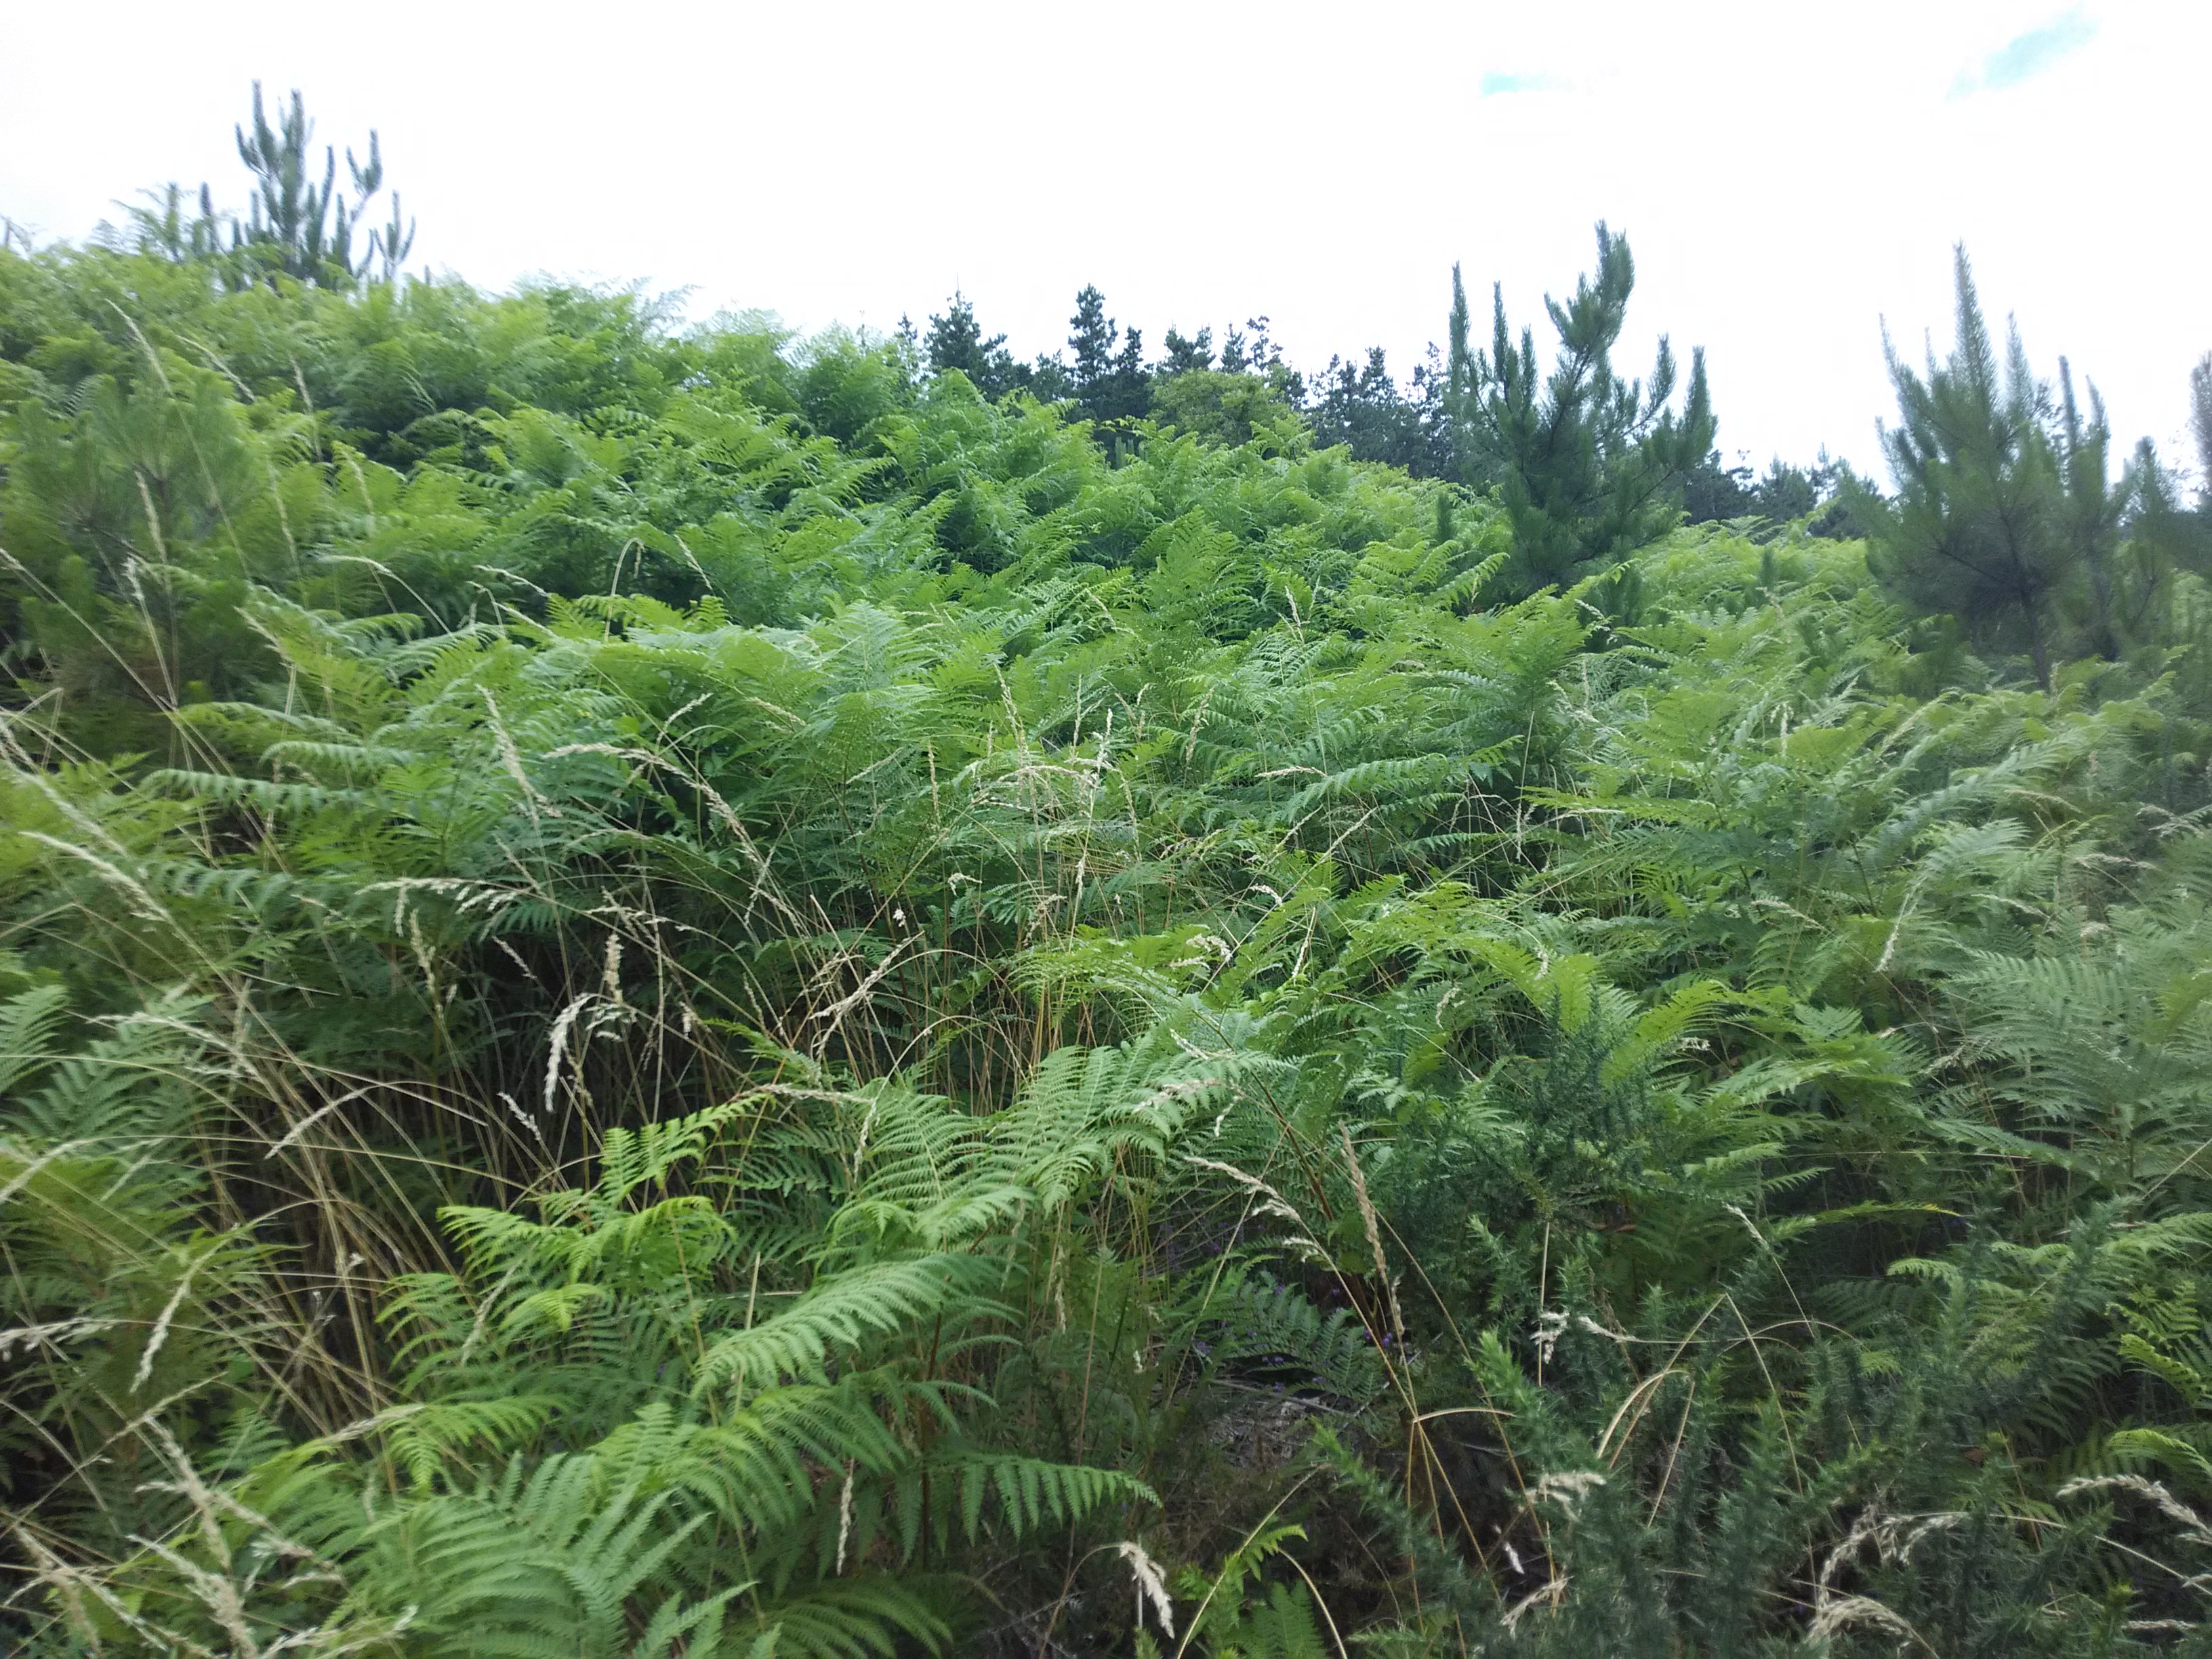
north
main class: Woodland
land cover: Pine dominated coniferous woodland
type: exotic forest
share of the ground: > 75 %
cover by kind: coniferous forest trees 100 %
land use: Forestry
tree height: < 5 m
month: July
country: ES
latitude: 43.1318
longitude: -2.5296
